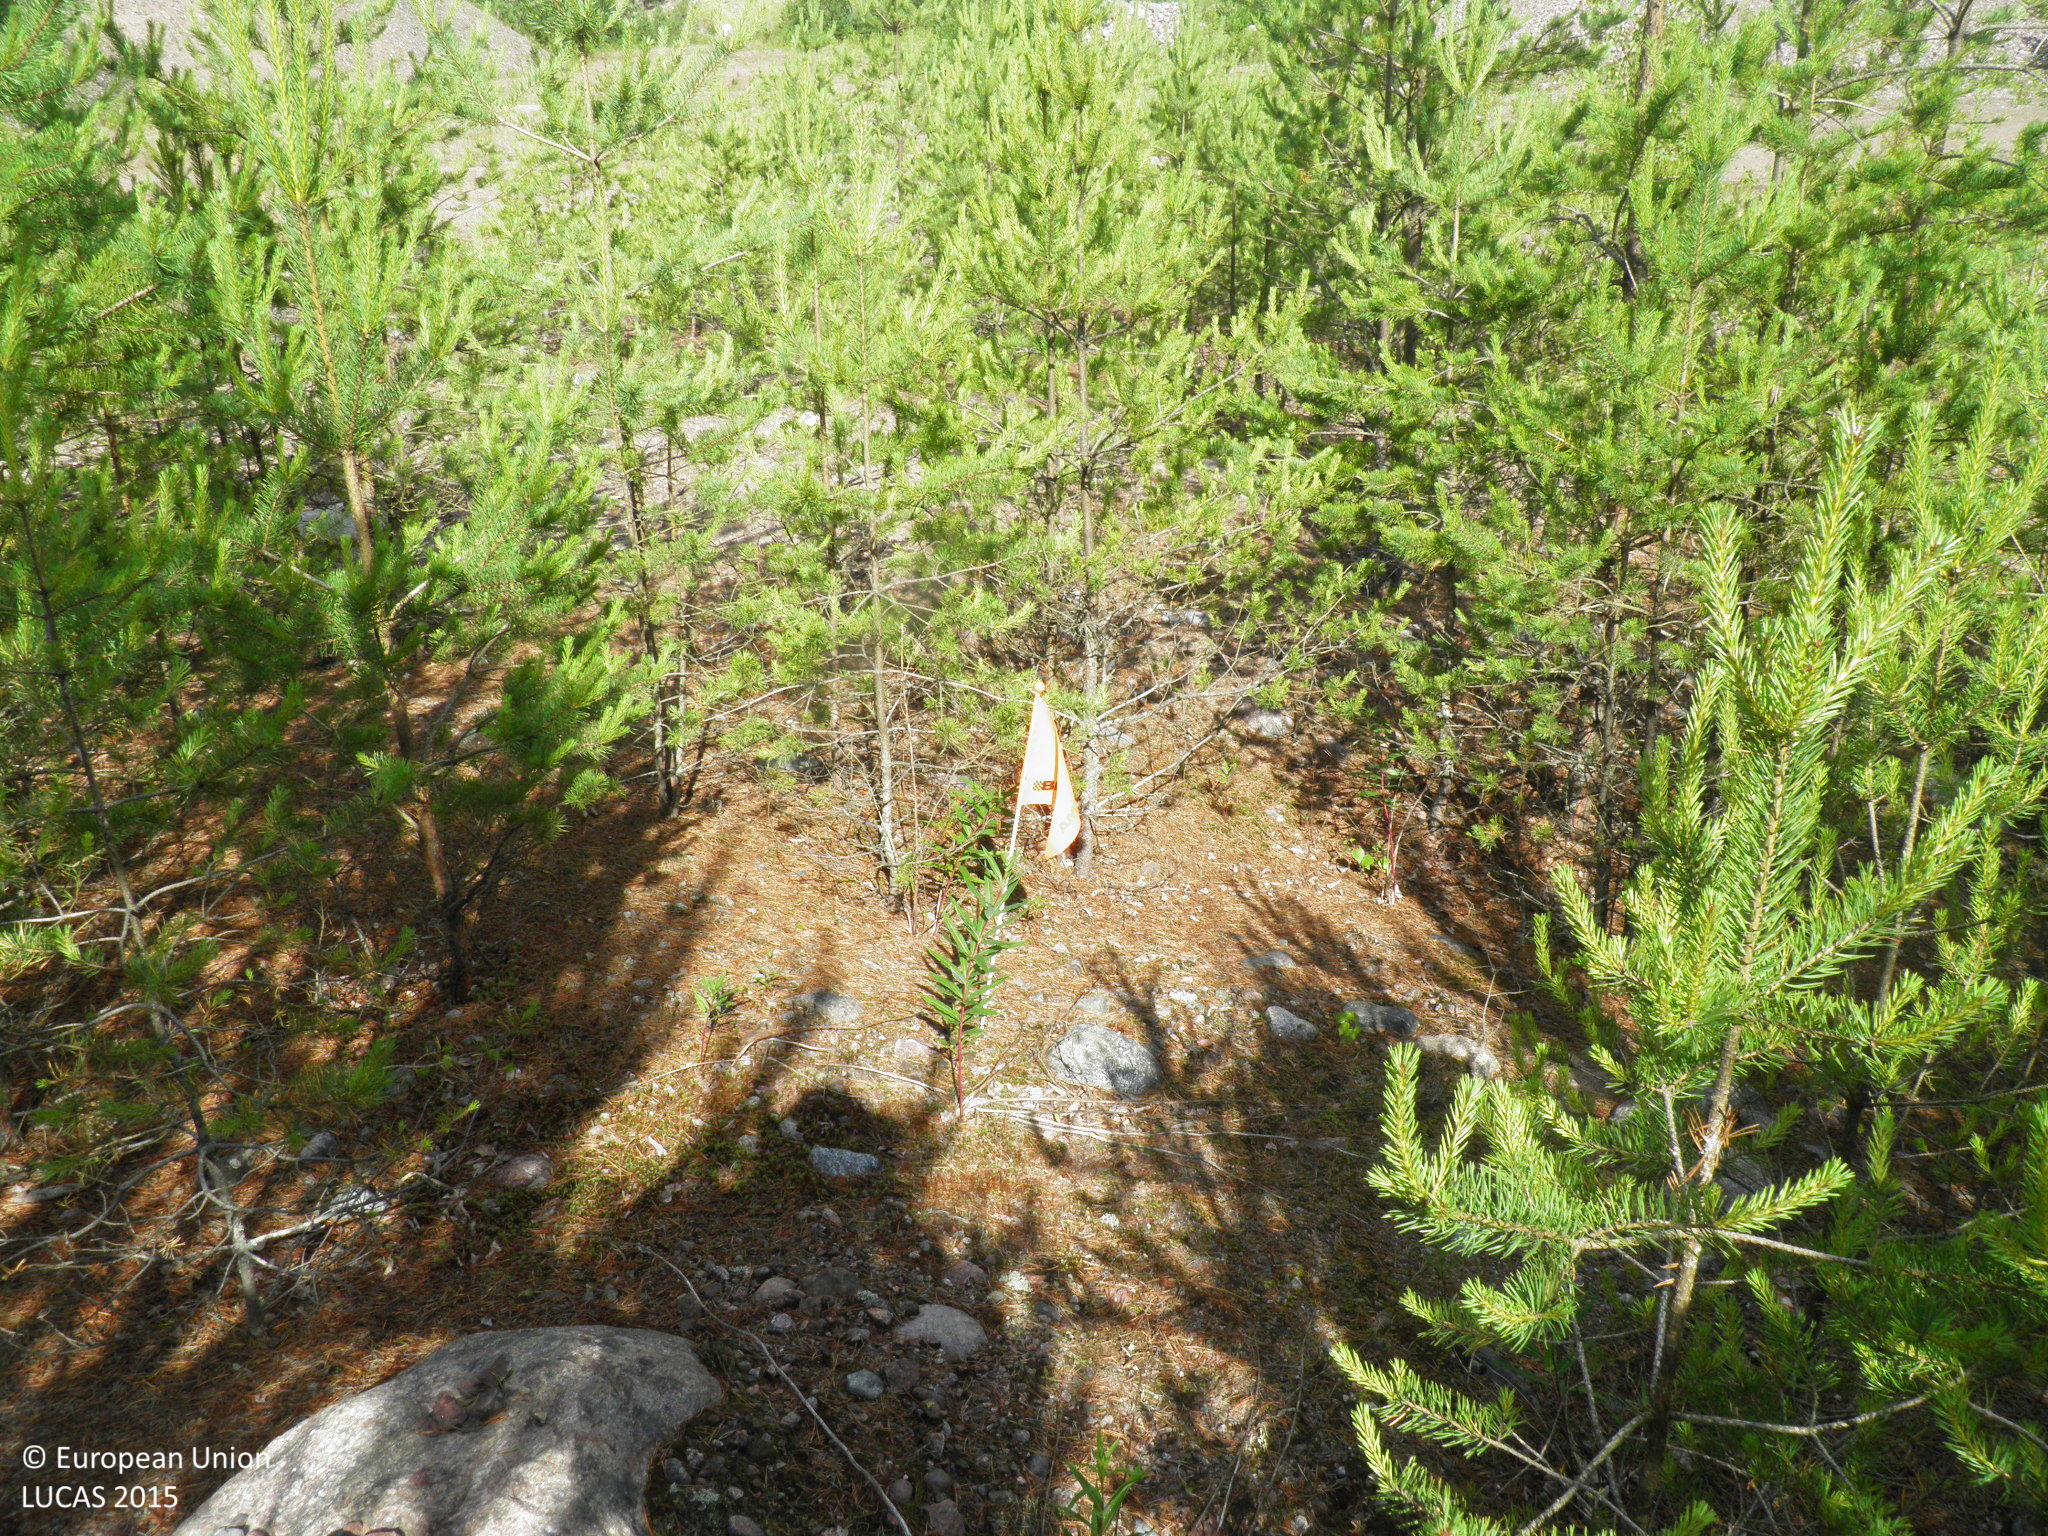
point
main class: Woodland
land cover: Pine dominated coniferous woodland
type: boreal forest
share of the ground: 25 - 50 %
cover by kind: coniferous forest trees 40 %, consolidated bare surface 30 %, unconsolidated bare surface 30 %
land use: Abandoned areas
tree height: < 5 m
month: July
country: FI
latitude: 60.8210
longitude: 22.7782
